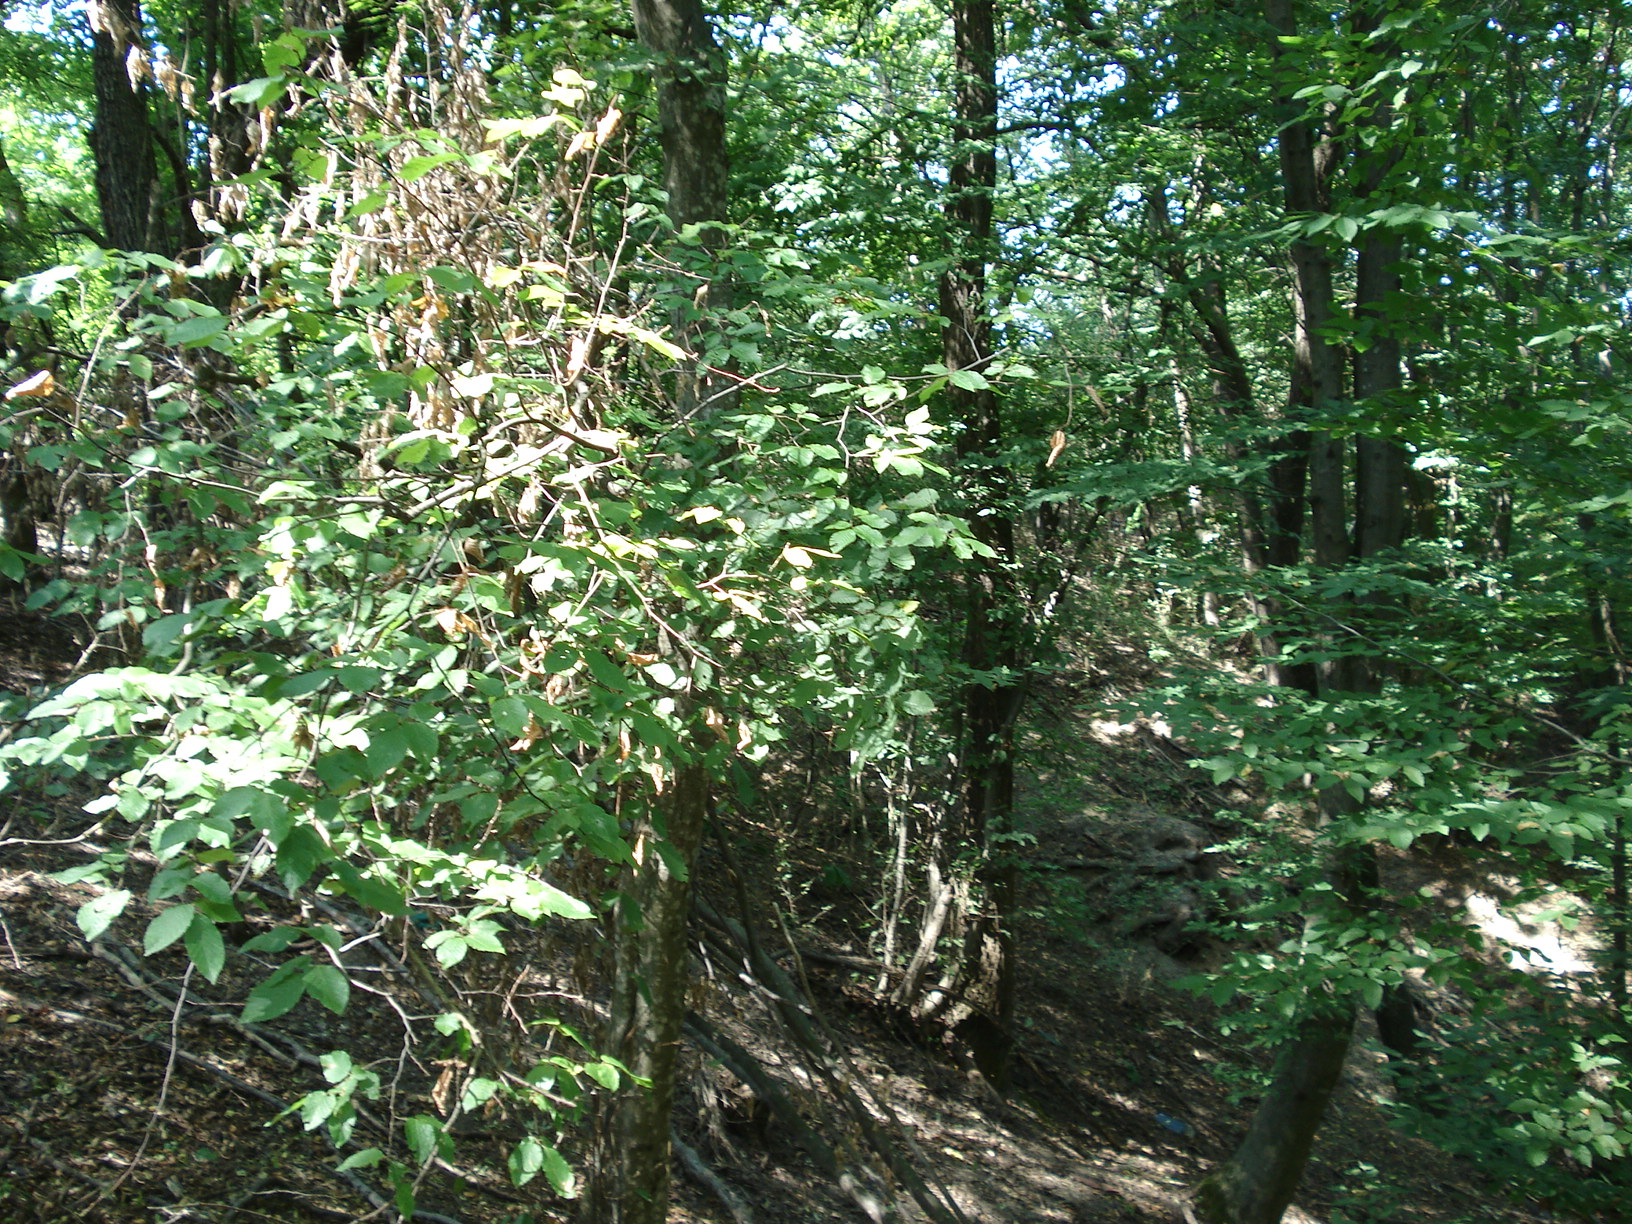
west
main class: Woodland
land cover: Broadleaved woodland
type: beech forest
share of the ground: > 75 %
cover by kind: broadleaved forest trees 80 %, unconsolidated bare surface 20 %
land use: Forestry
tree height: > 5 m
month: September
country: BG
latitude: 43.2110
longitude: 26.1057
